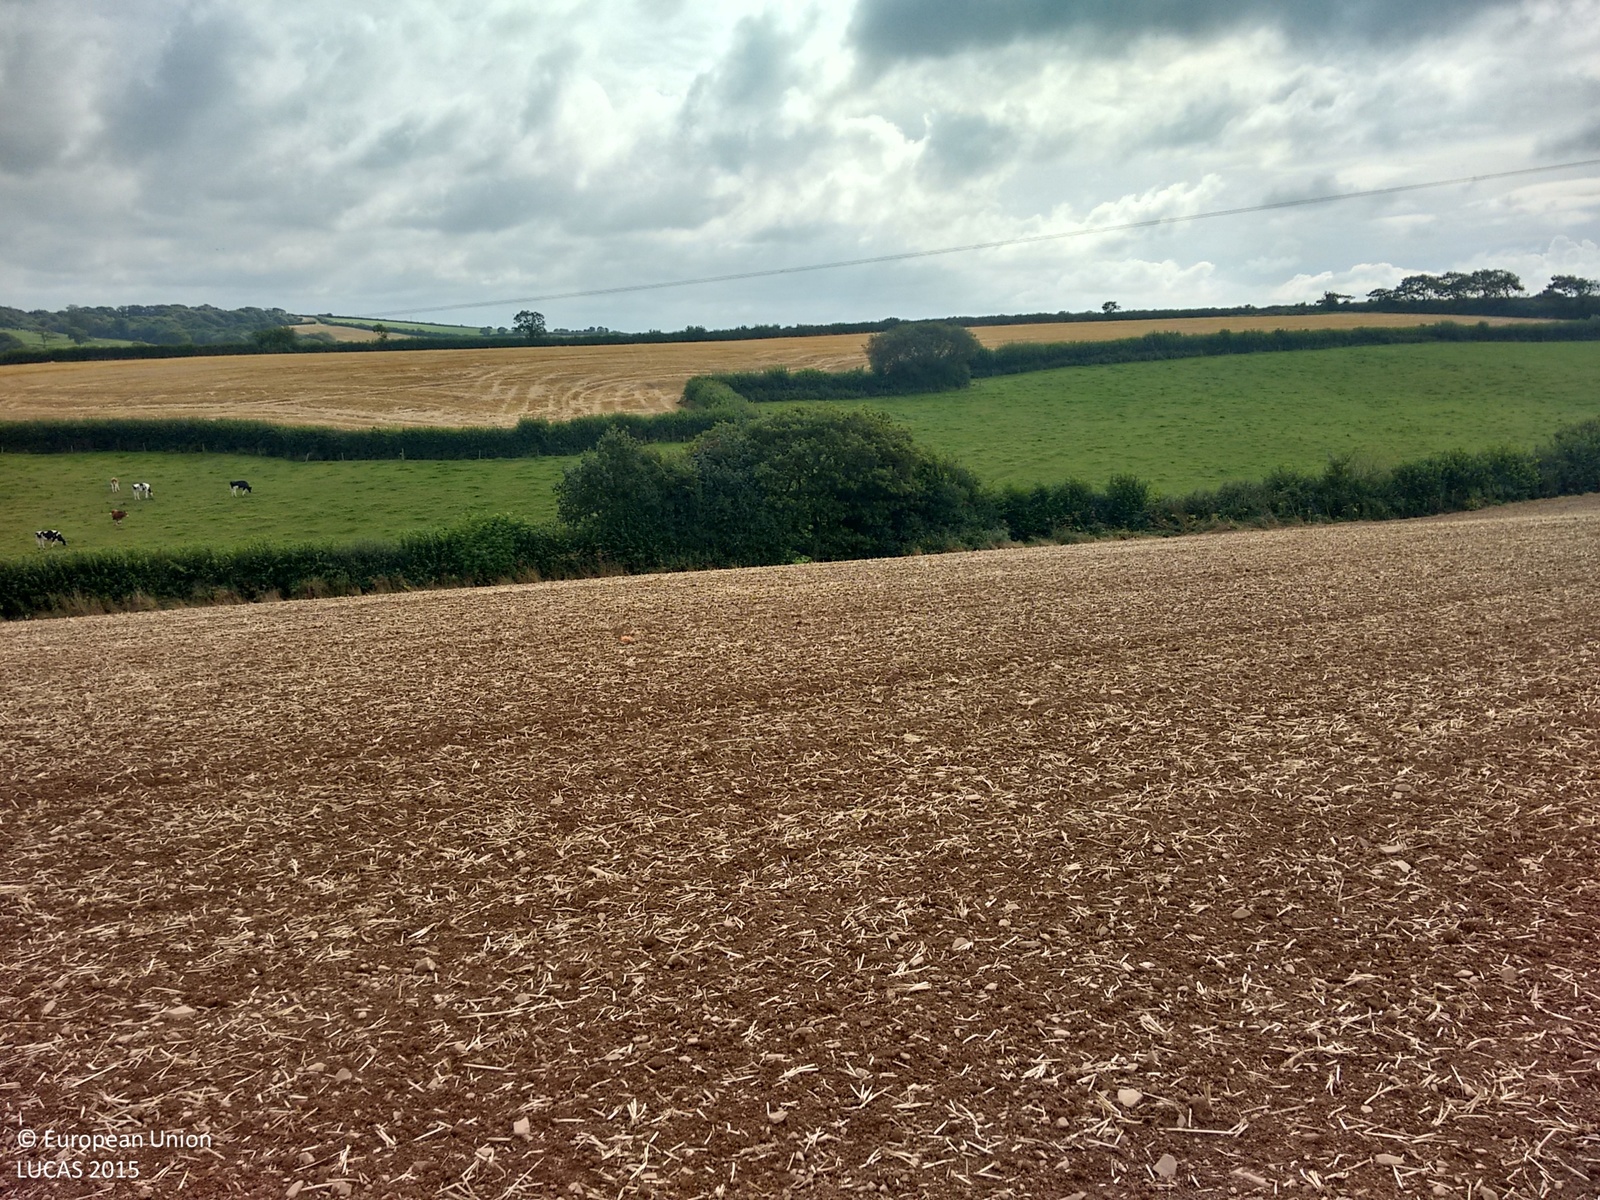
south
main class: Cropland
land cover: Barley
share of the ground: 10 - 25 %
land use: Agriculture (excluding fallow land and kitchen gardens)
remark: Harvested field
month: September
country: GB
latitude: 50.7683
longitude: -4.3514
